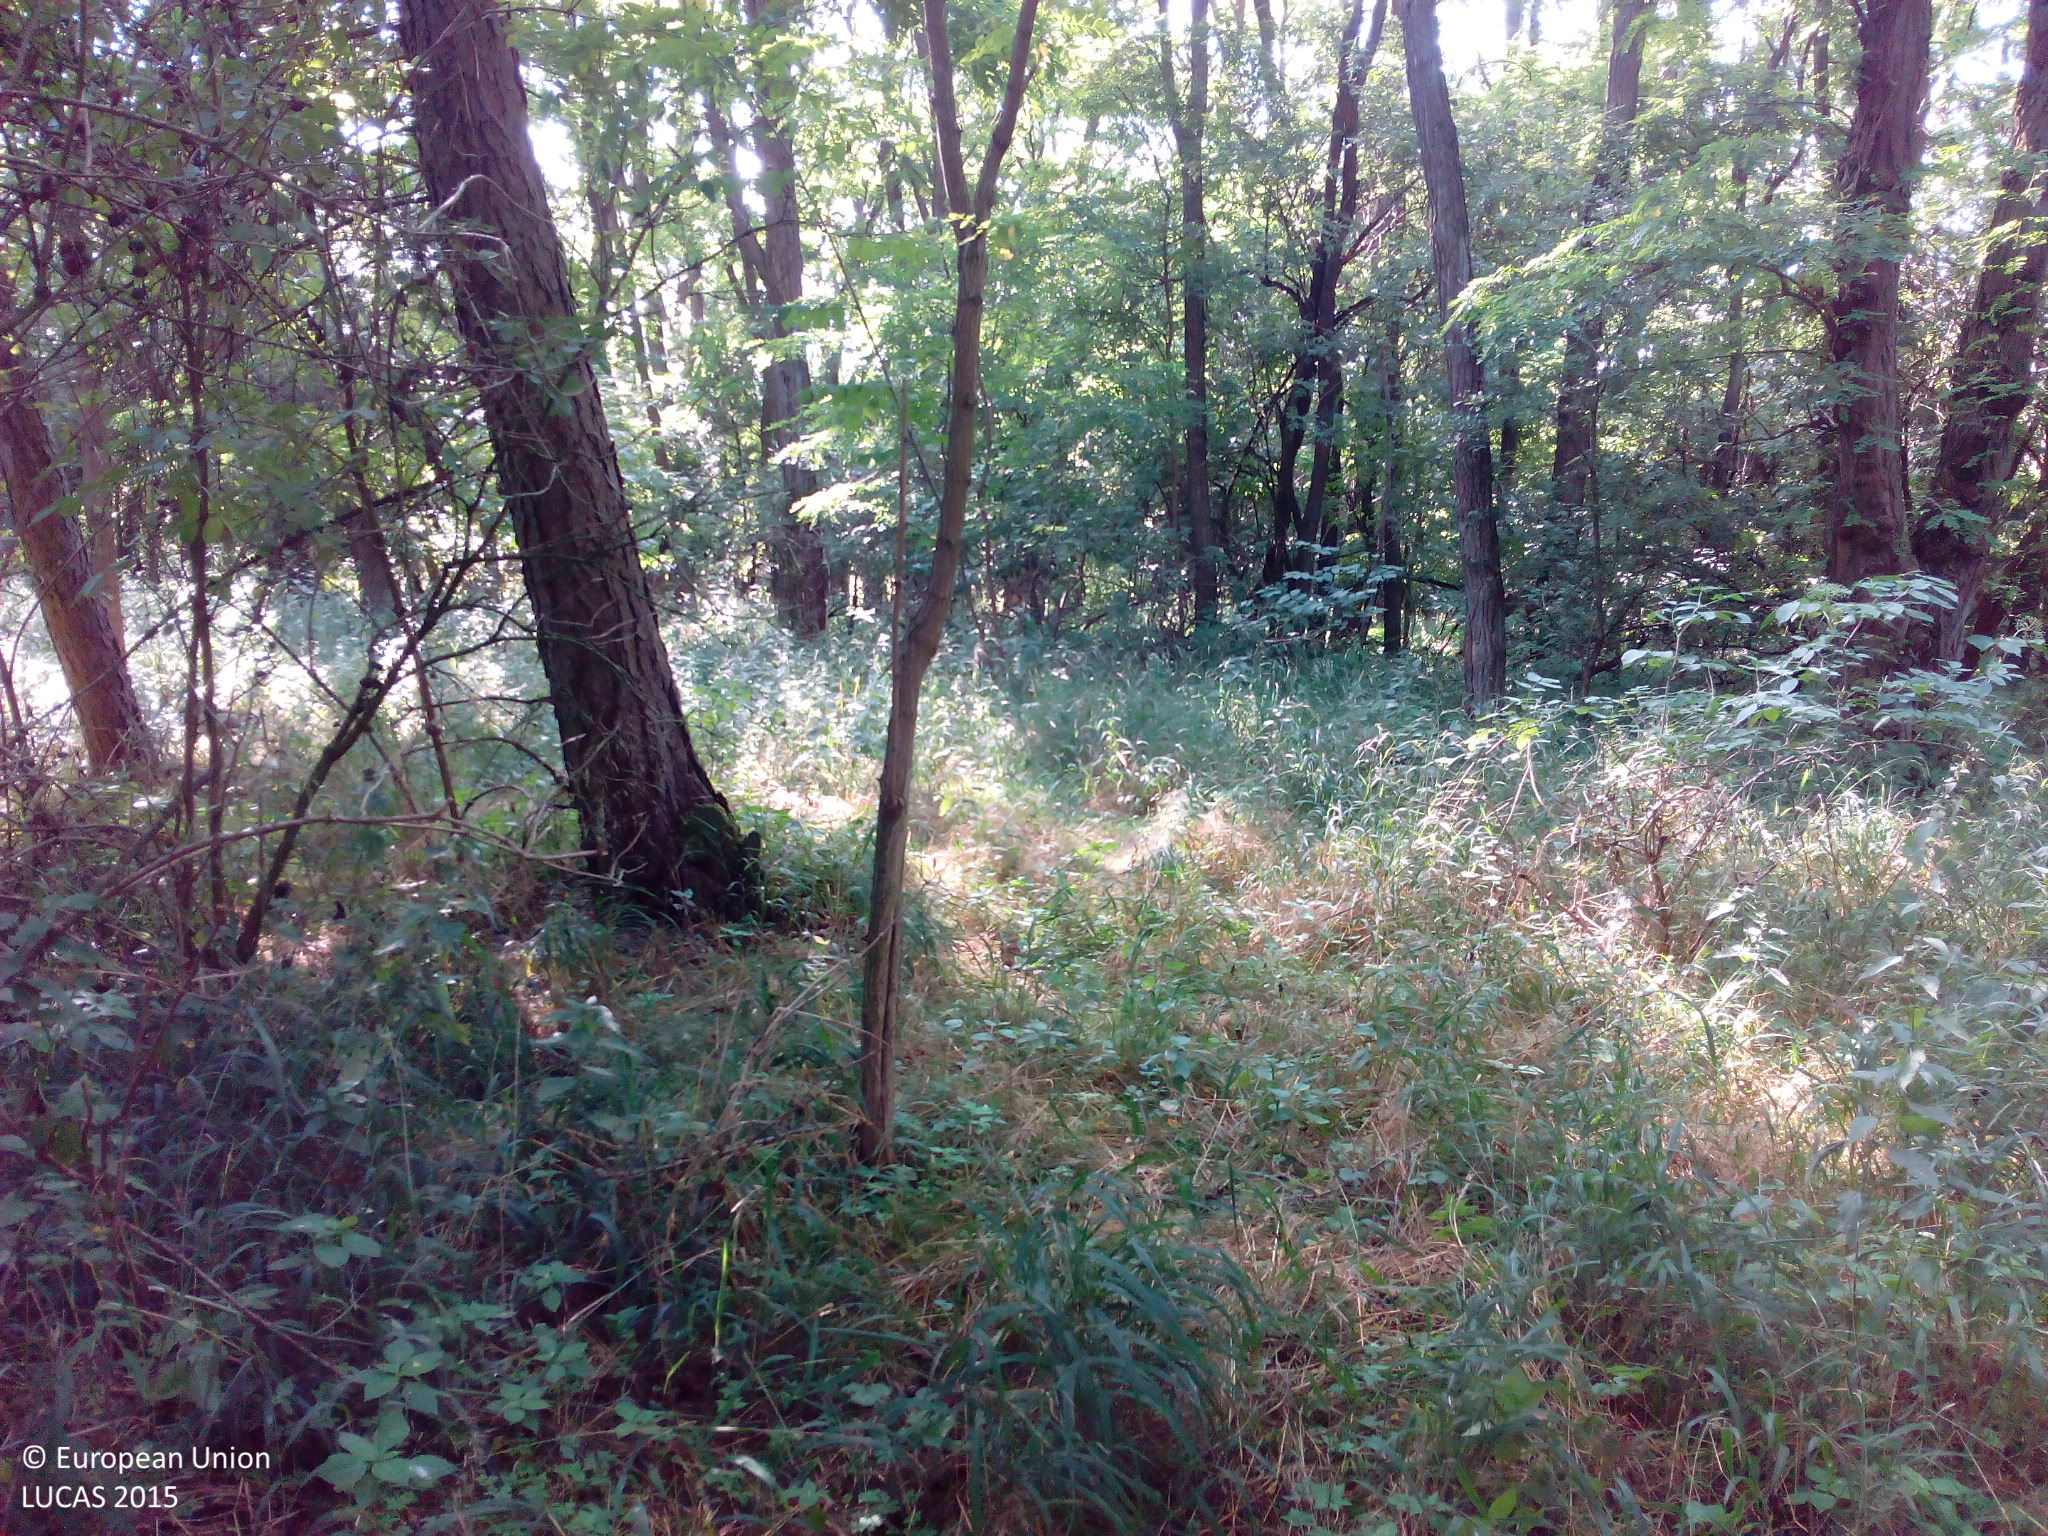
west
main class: Woodland
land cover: Other coniferous woodland
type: hemiboreal forest and nemoral coniferous forest and mixed broadleaved-coniferous forest
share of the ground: > 75 %
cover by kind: coniferous forest trees 75 %, broadleaved forest trees 10 %, shrubs 10 %, herbaceous plants 5 %
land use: Forestry
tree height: > 5 m
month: August
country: DE
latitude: 53.4923
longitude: 13.6023
